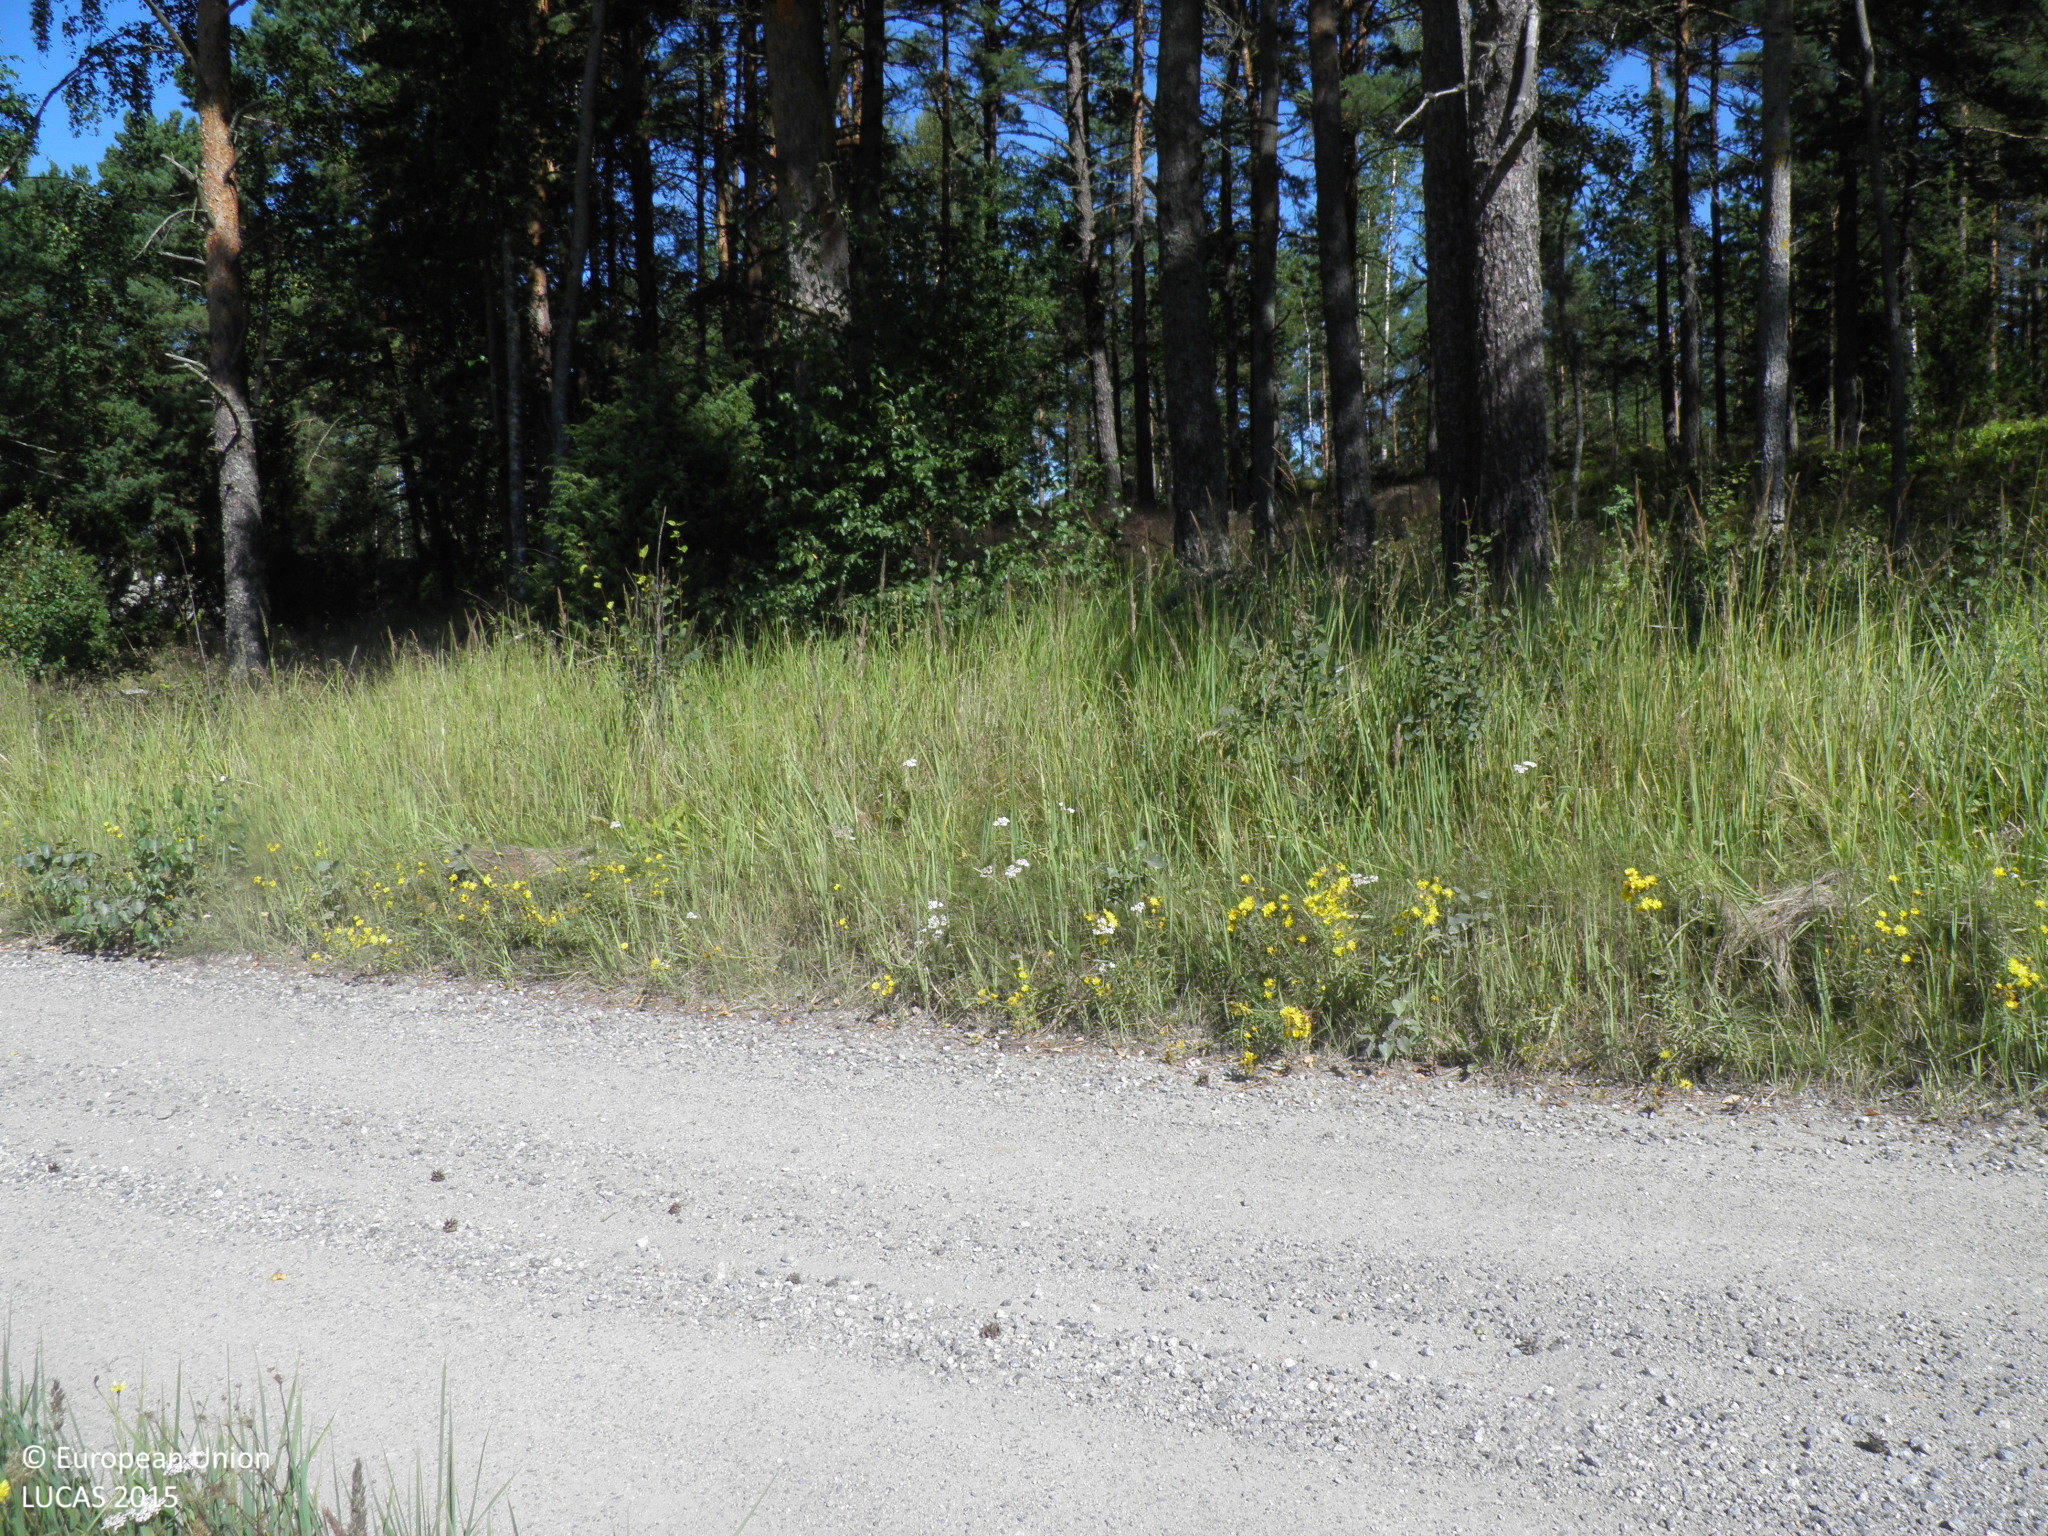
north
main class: Cropland
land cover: Oats
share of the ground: > 75 %
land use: Agriculture (excluding fallow land and kitchen gardens)
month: August
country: FI
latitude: 60.9816
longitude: 21.3060
